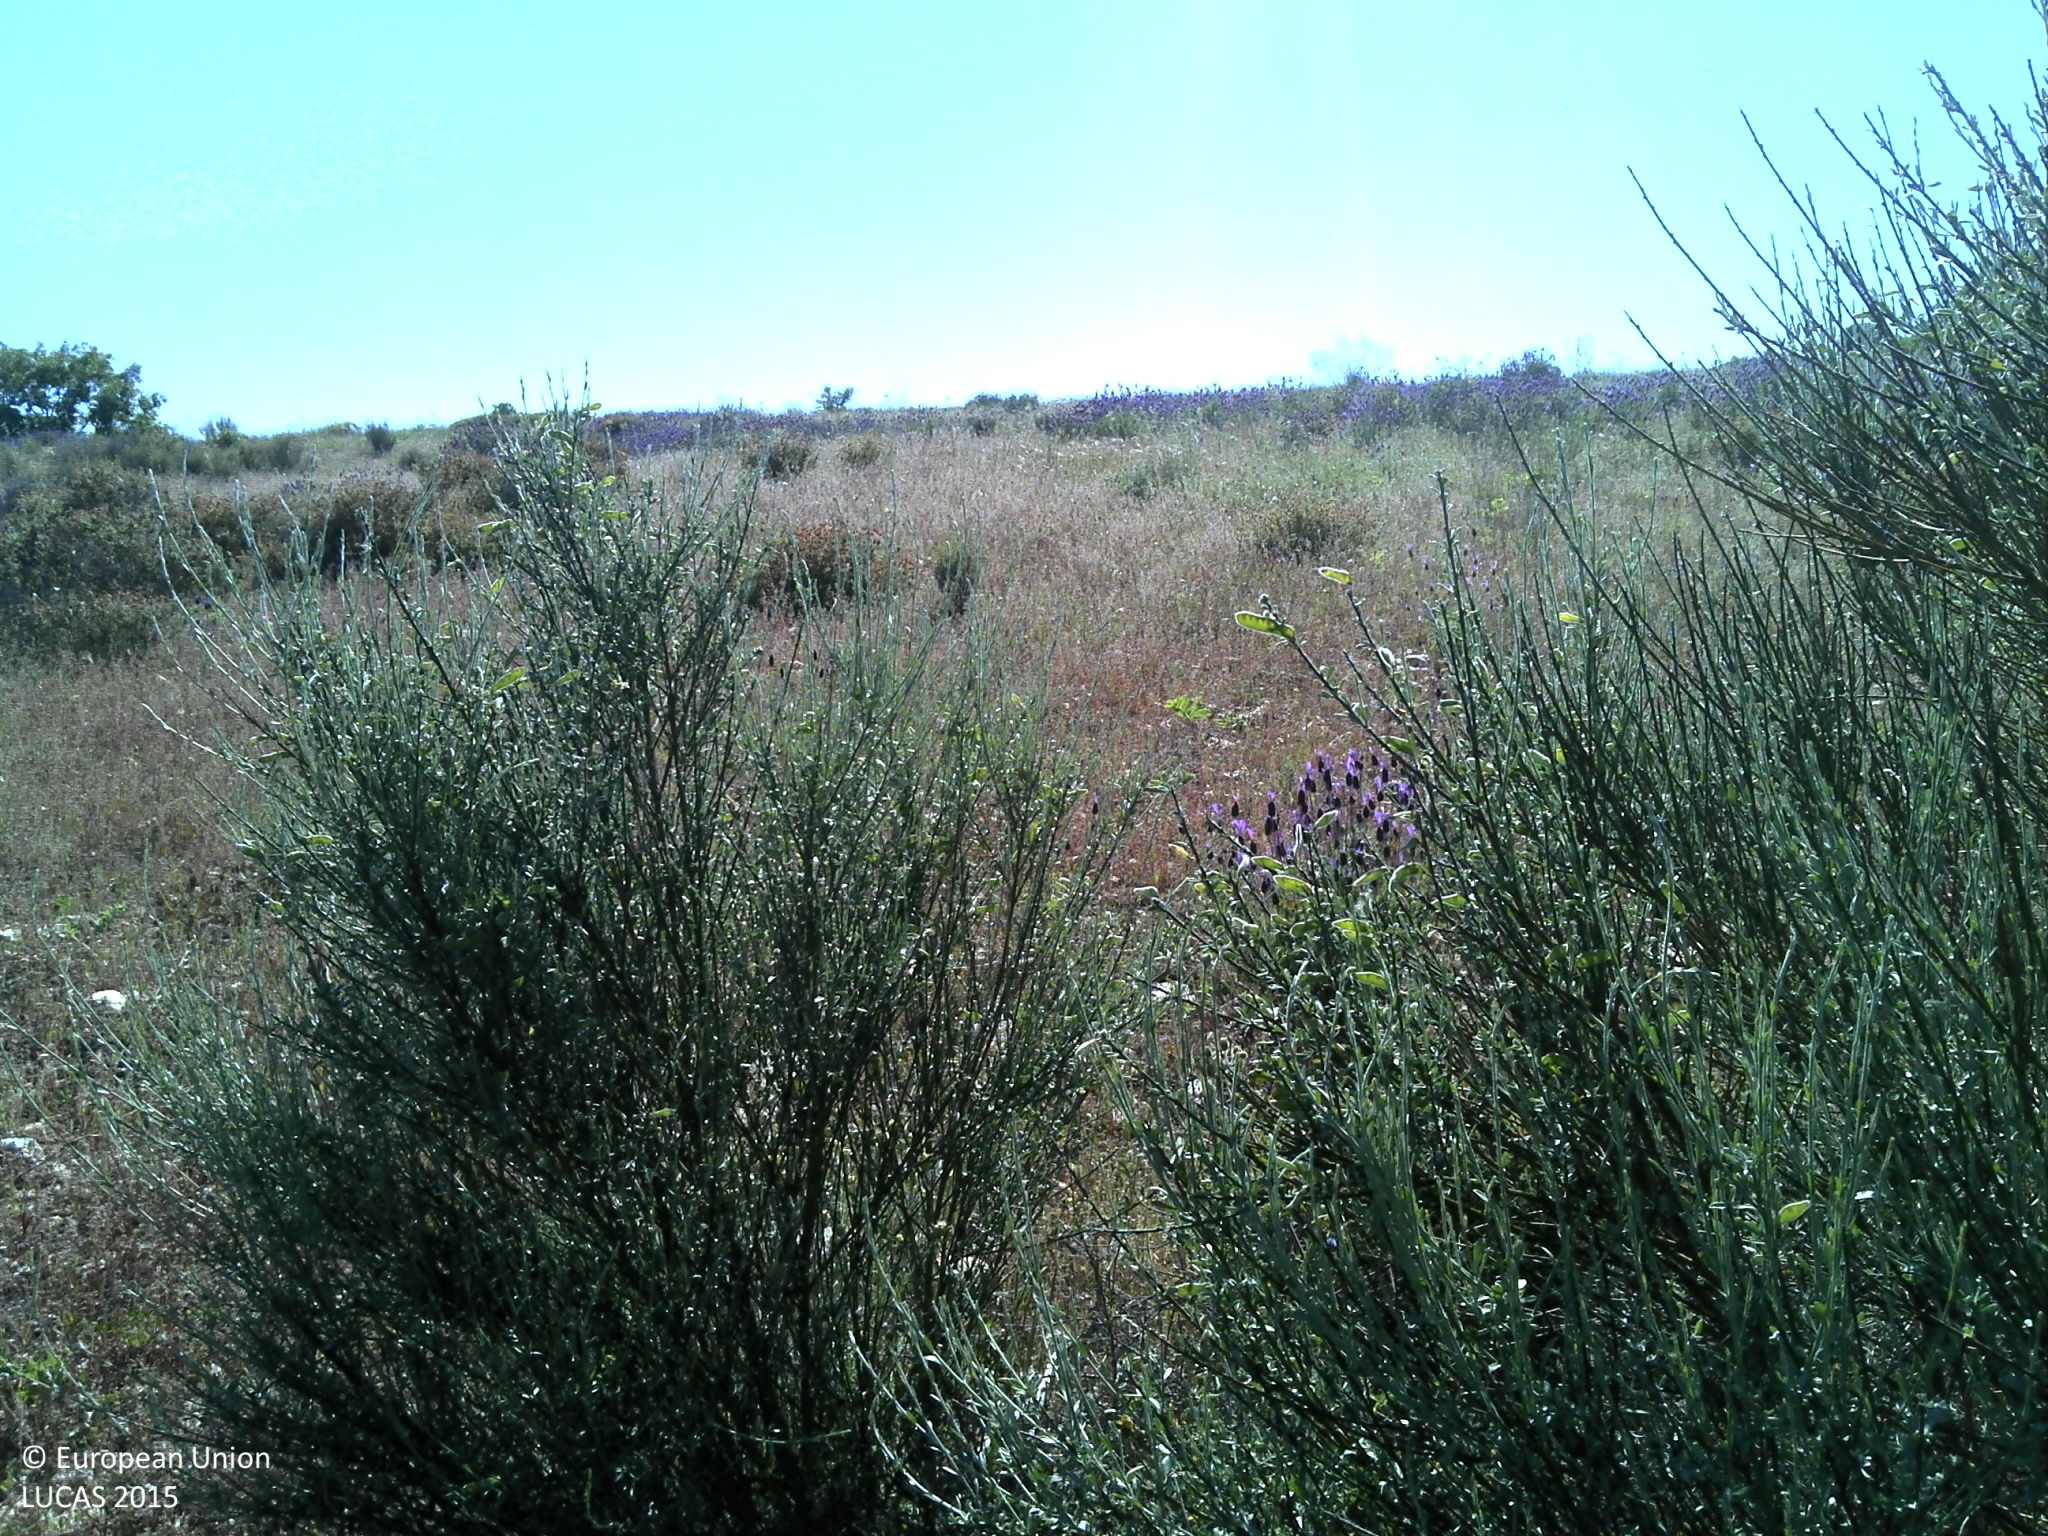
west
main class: Shrubland
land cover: Shrubland without tree cover
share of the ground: 25 - 50 %
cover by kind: shrubs 50 %, unconsolidated bare surface 30 %, herbaceous plants 20 %
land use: Abandoned areas
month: May
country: PT
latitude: 41.4980
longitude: -6.3551
